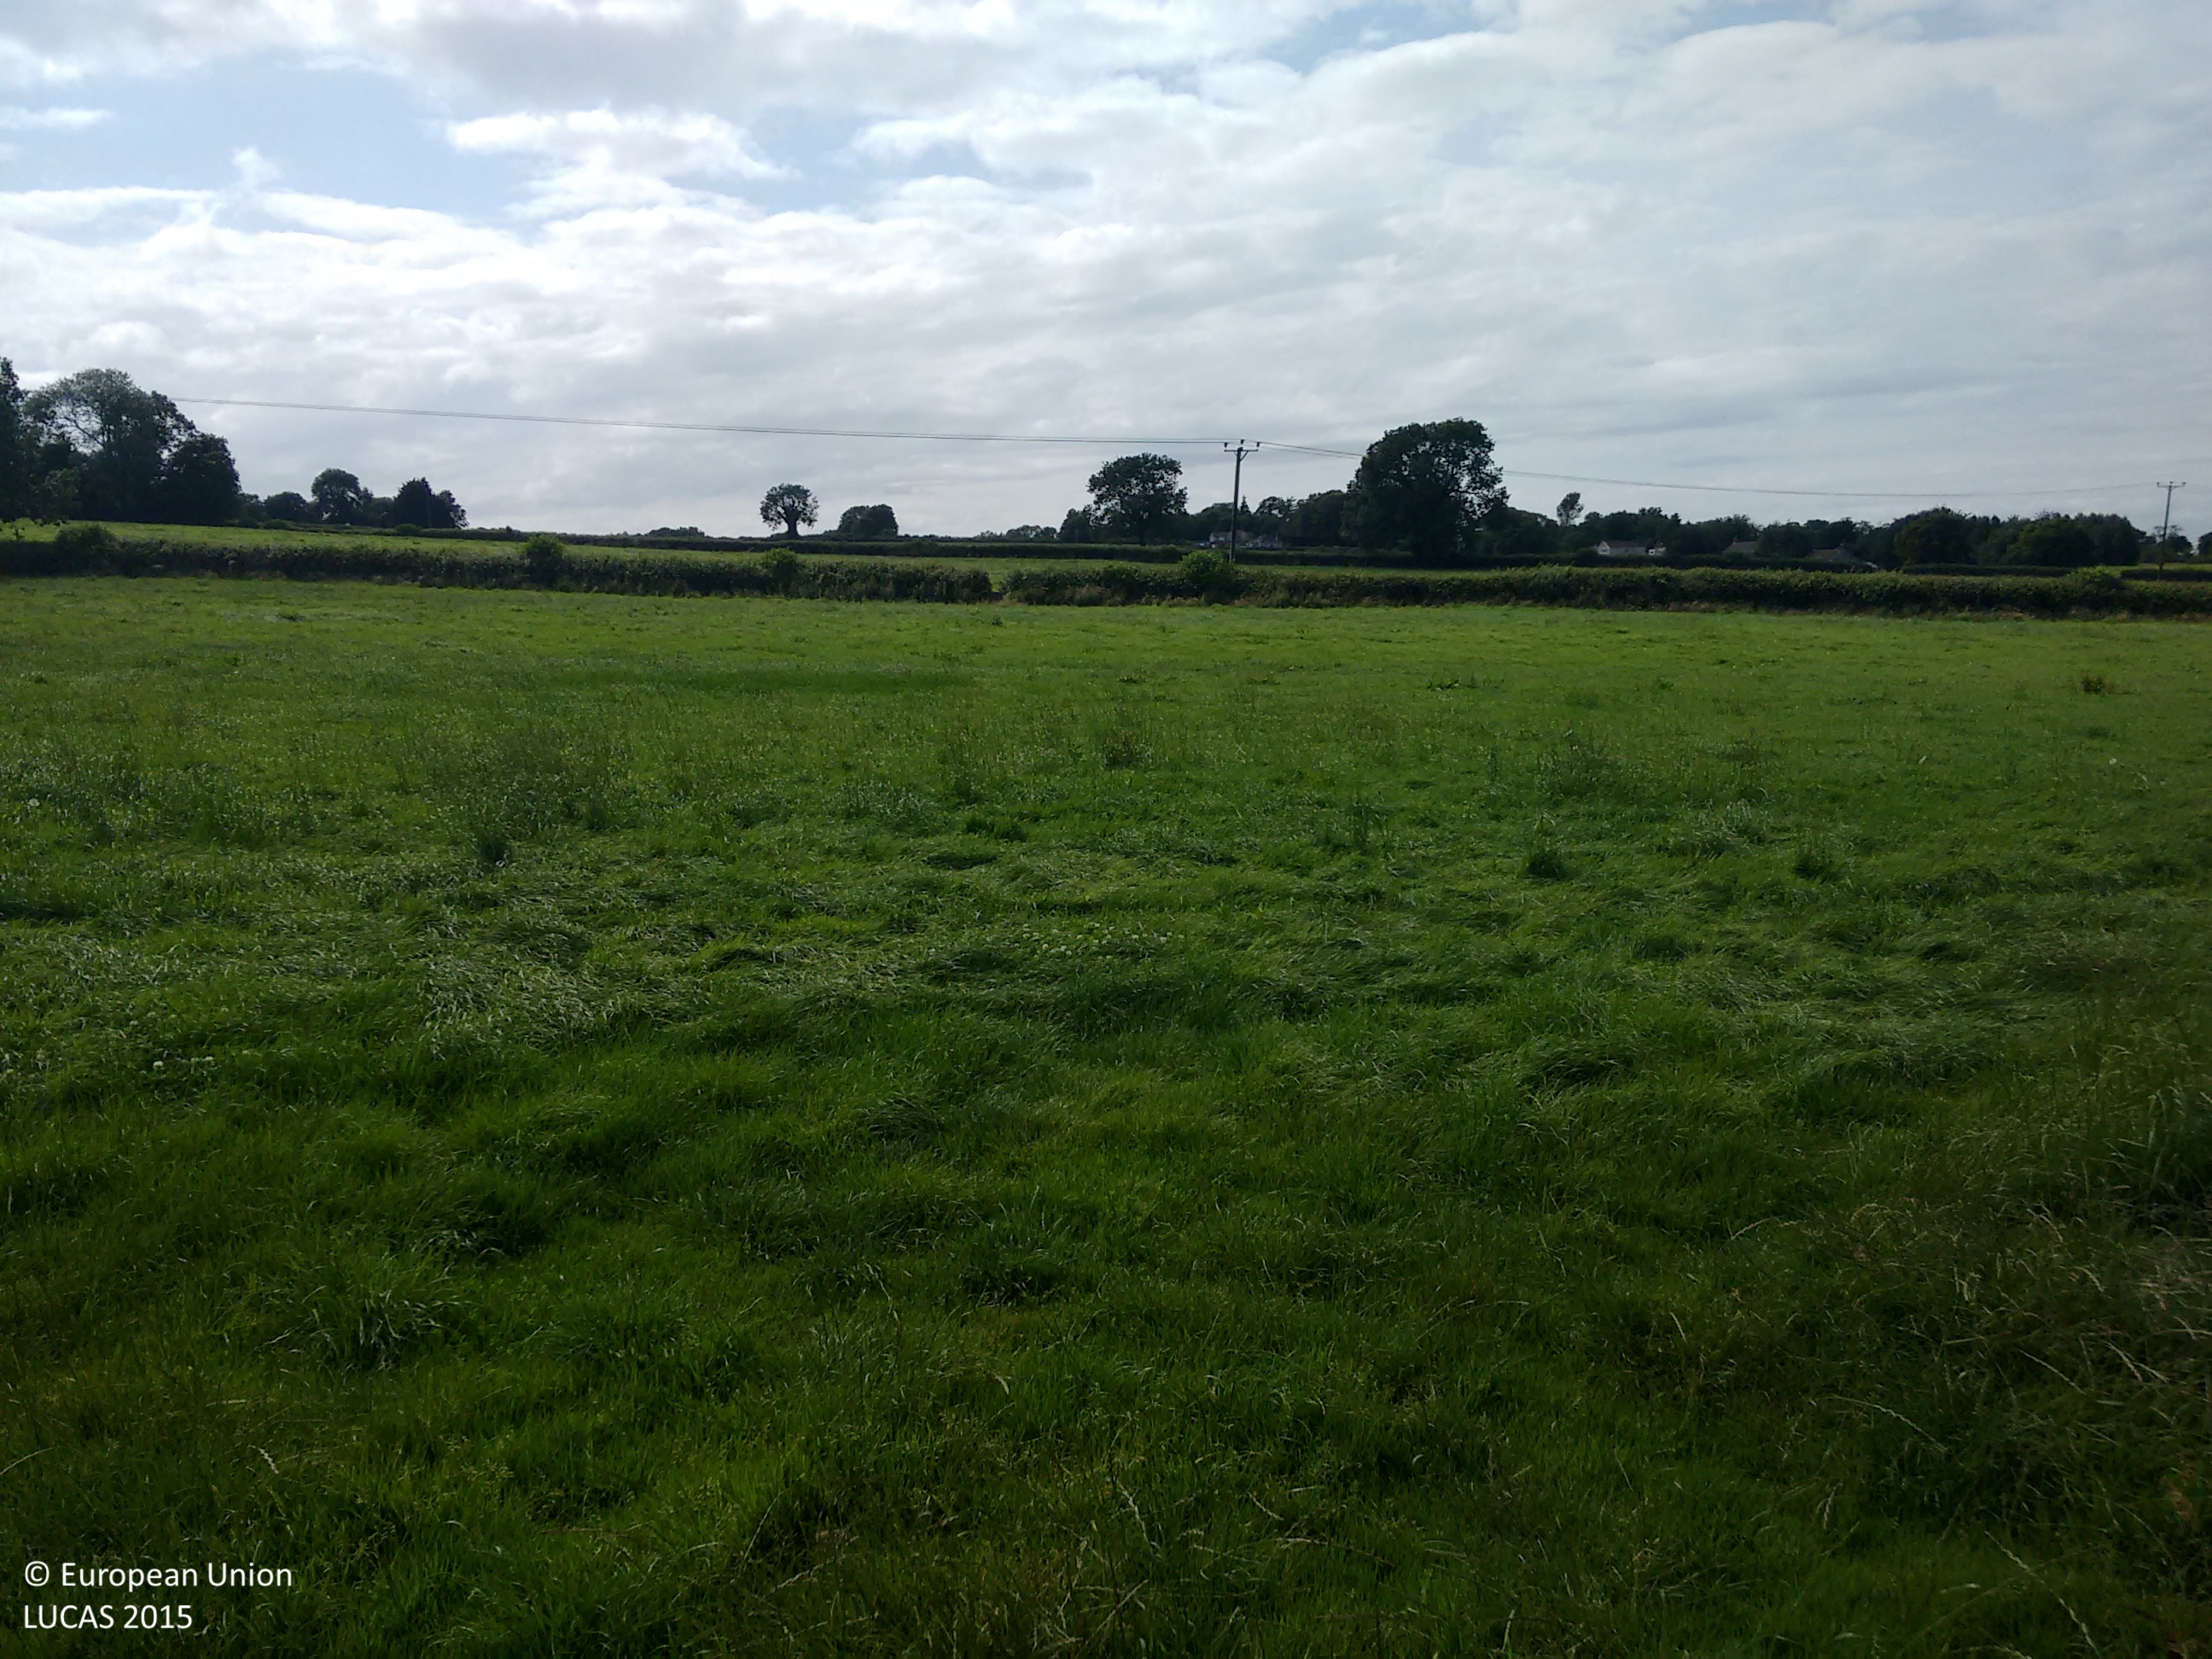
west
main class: Grassland
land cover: Grassland without tree/shrub cover
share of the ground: > 75 %
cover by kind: herbaceous plants 100 %
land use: Agriculture (excluding fallow land and kitchen gardens)
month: July
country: GB
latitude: 51.2565
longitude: -2.5187
